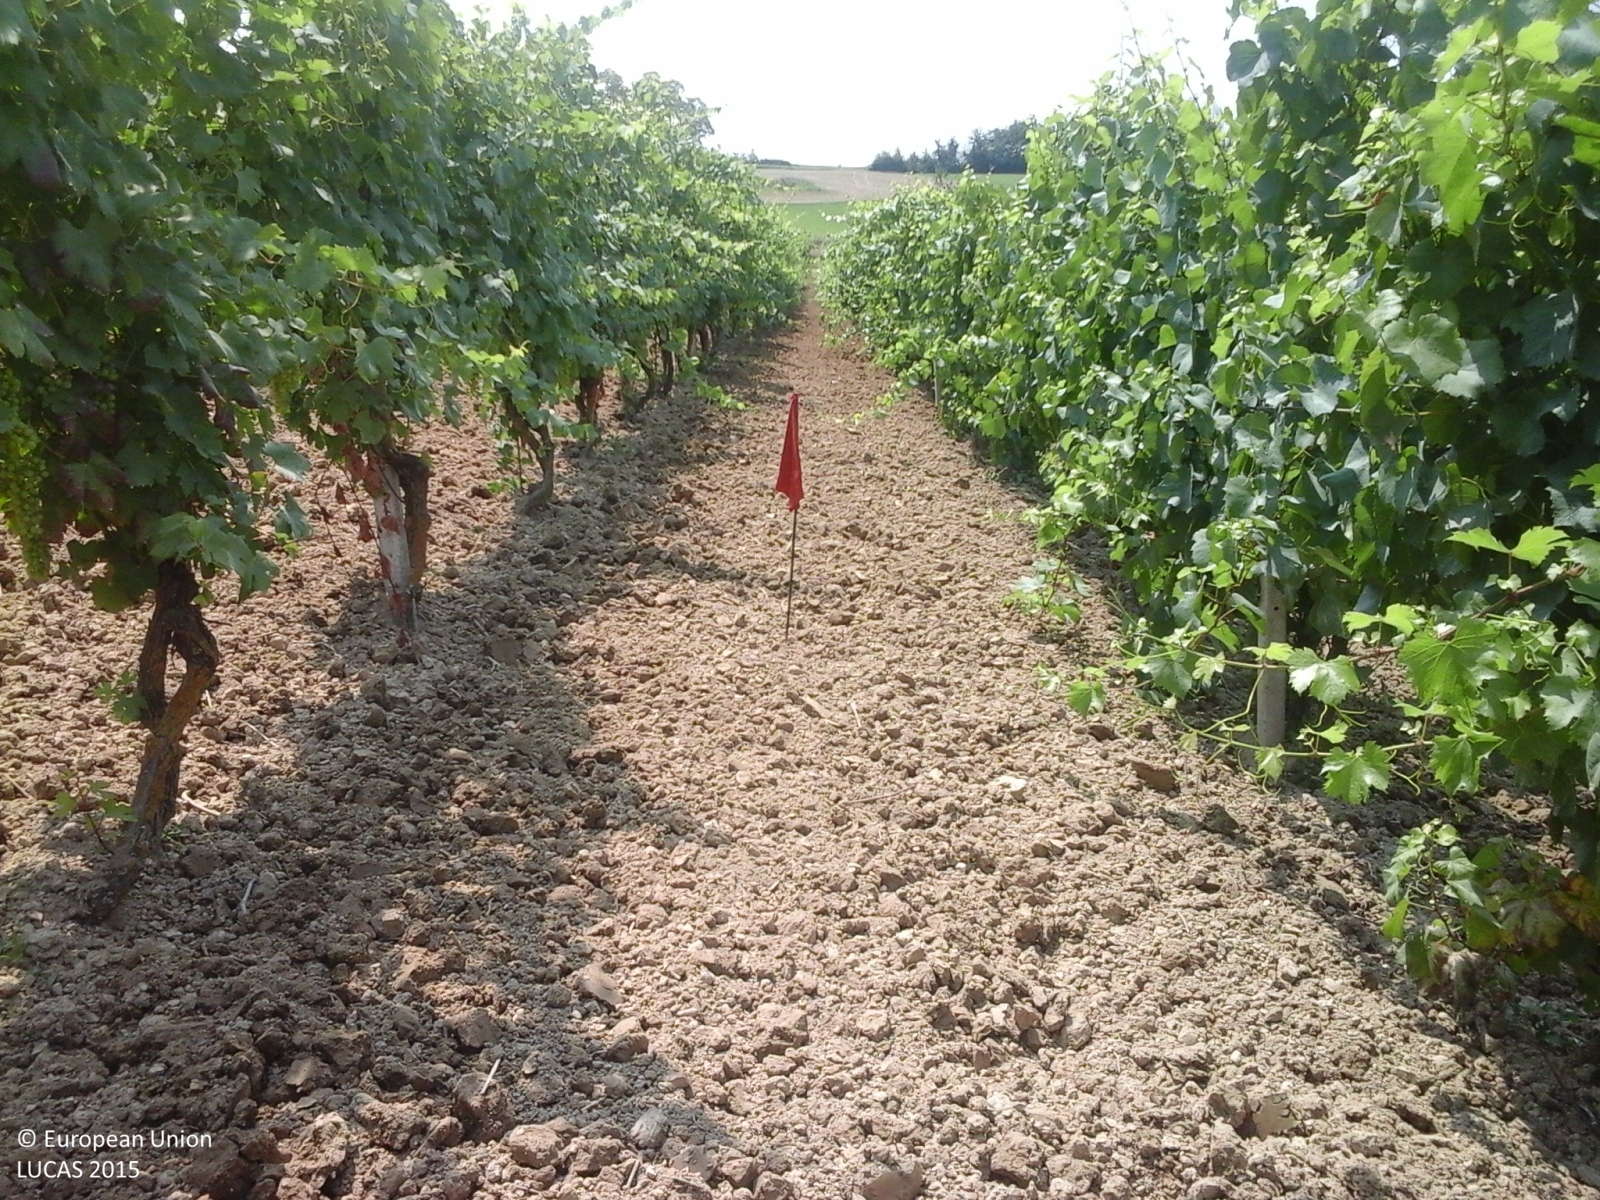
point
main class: Cropland
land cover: Vineyards
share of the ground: > 75 %
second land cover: Other bare soil
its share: > 75 %
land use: Agriculture (excluding fallow land and kitchen gardens)
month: June
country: IT
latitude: 44.9892
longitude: 8.5189
